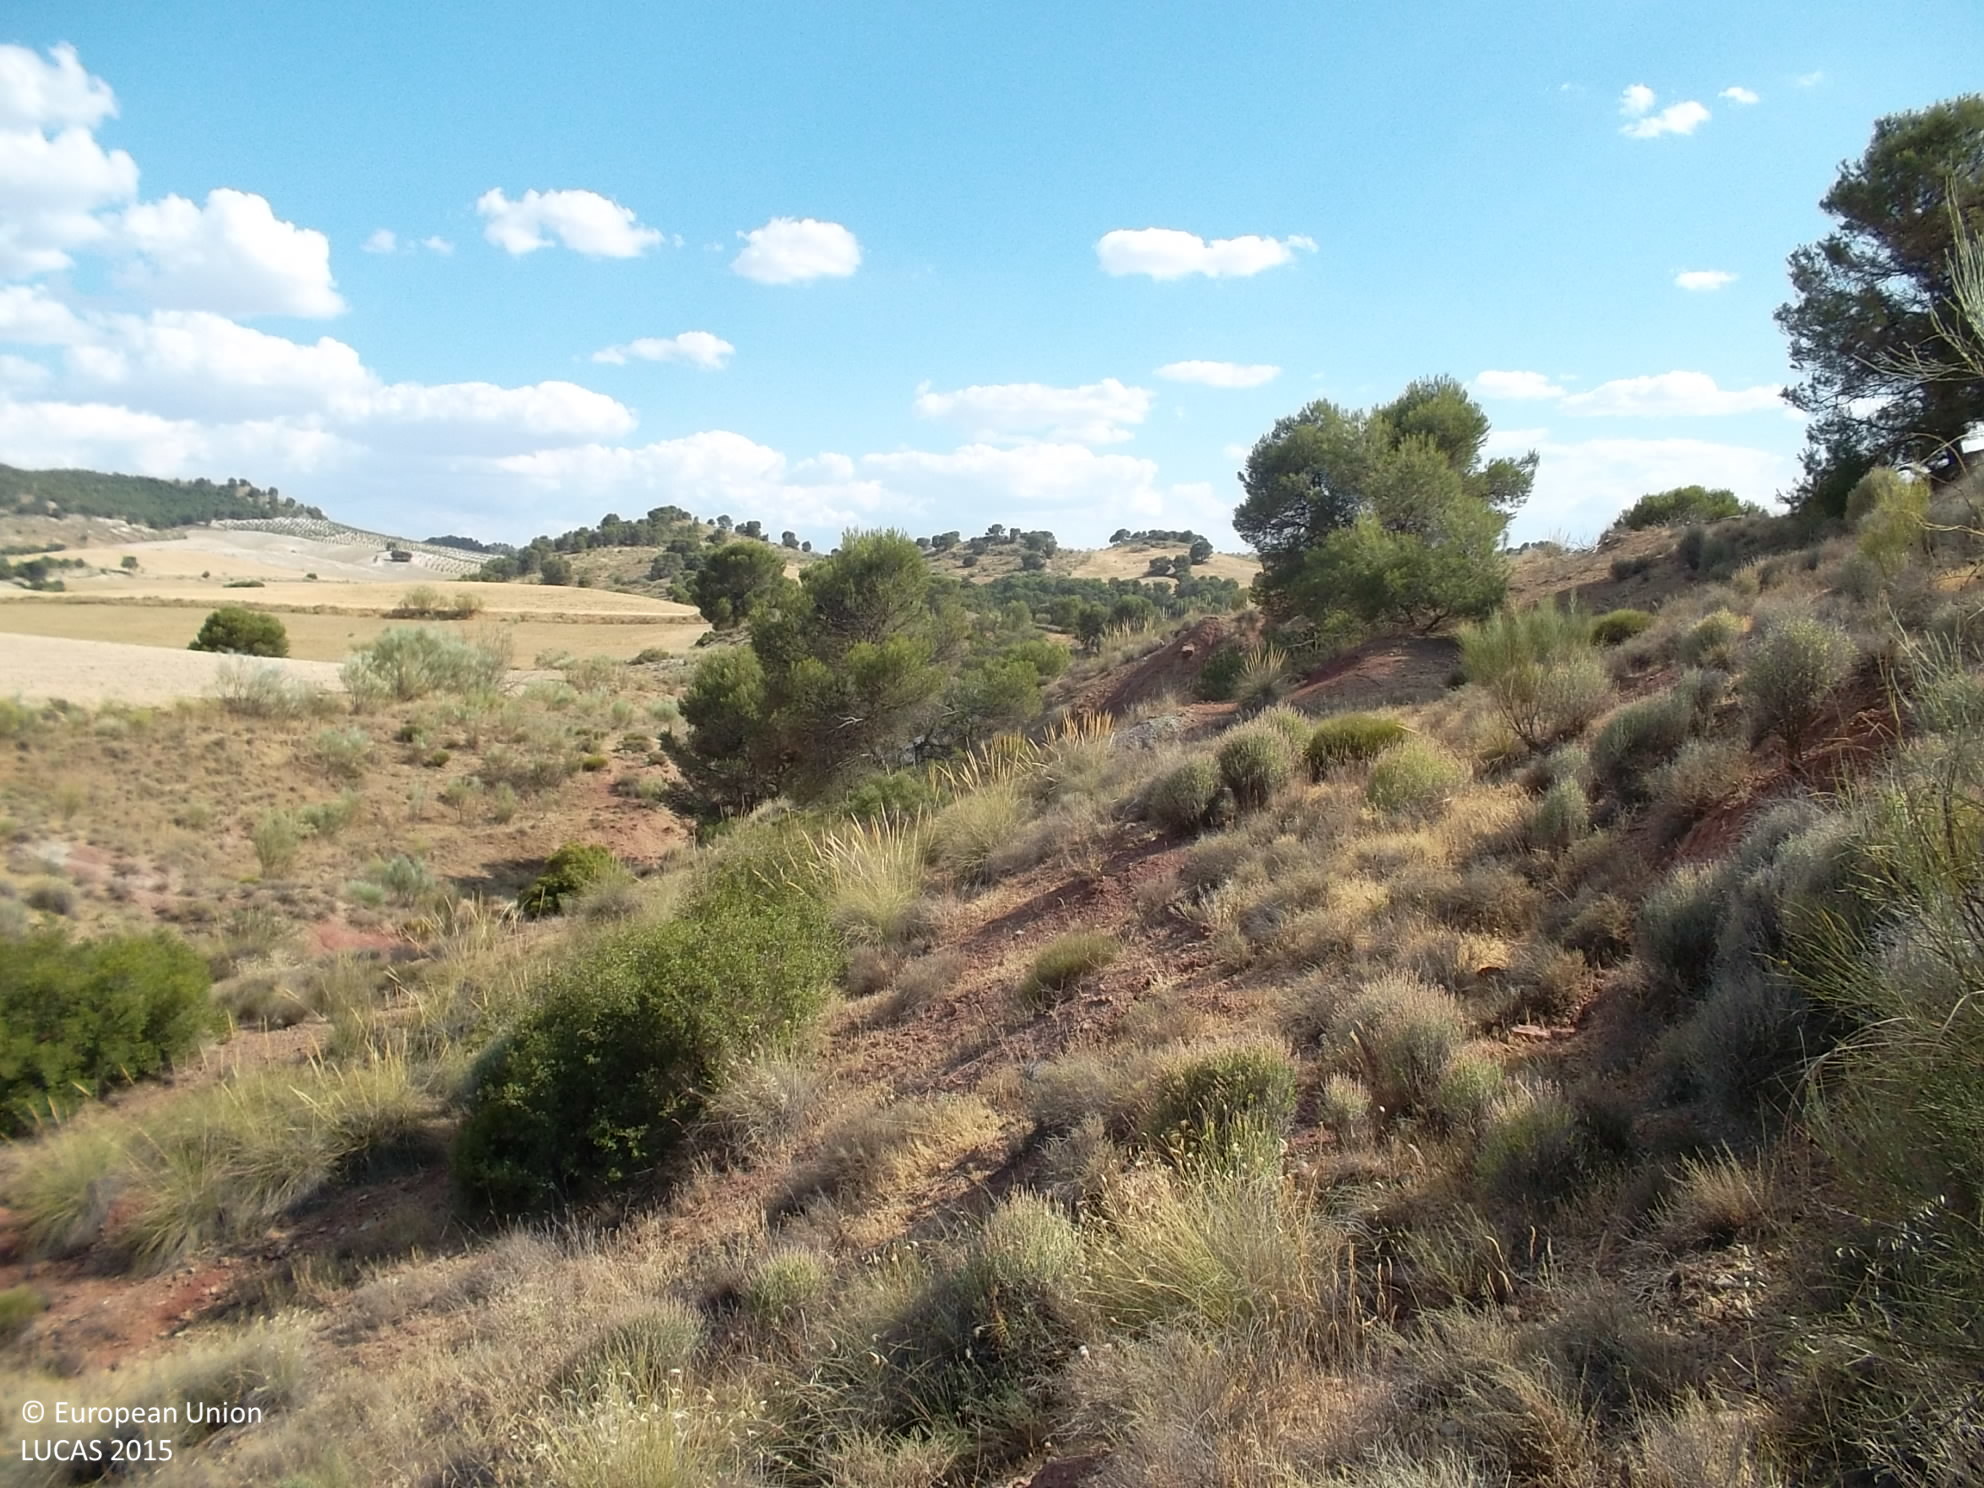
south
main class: Shrubland
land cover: Shrubland without tree cover
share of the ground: 50 - 75 %
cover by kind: herbaceous plants 60 %, shrubs 40 %
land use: Semi-natural and natural areas not in use
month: June
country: ES
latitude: 37.7057
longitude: -3.1853
